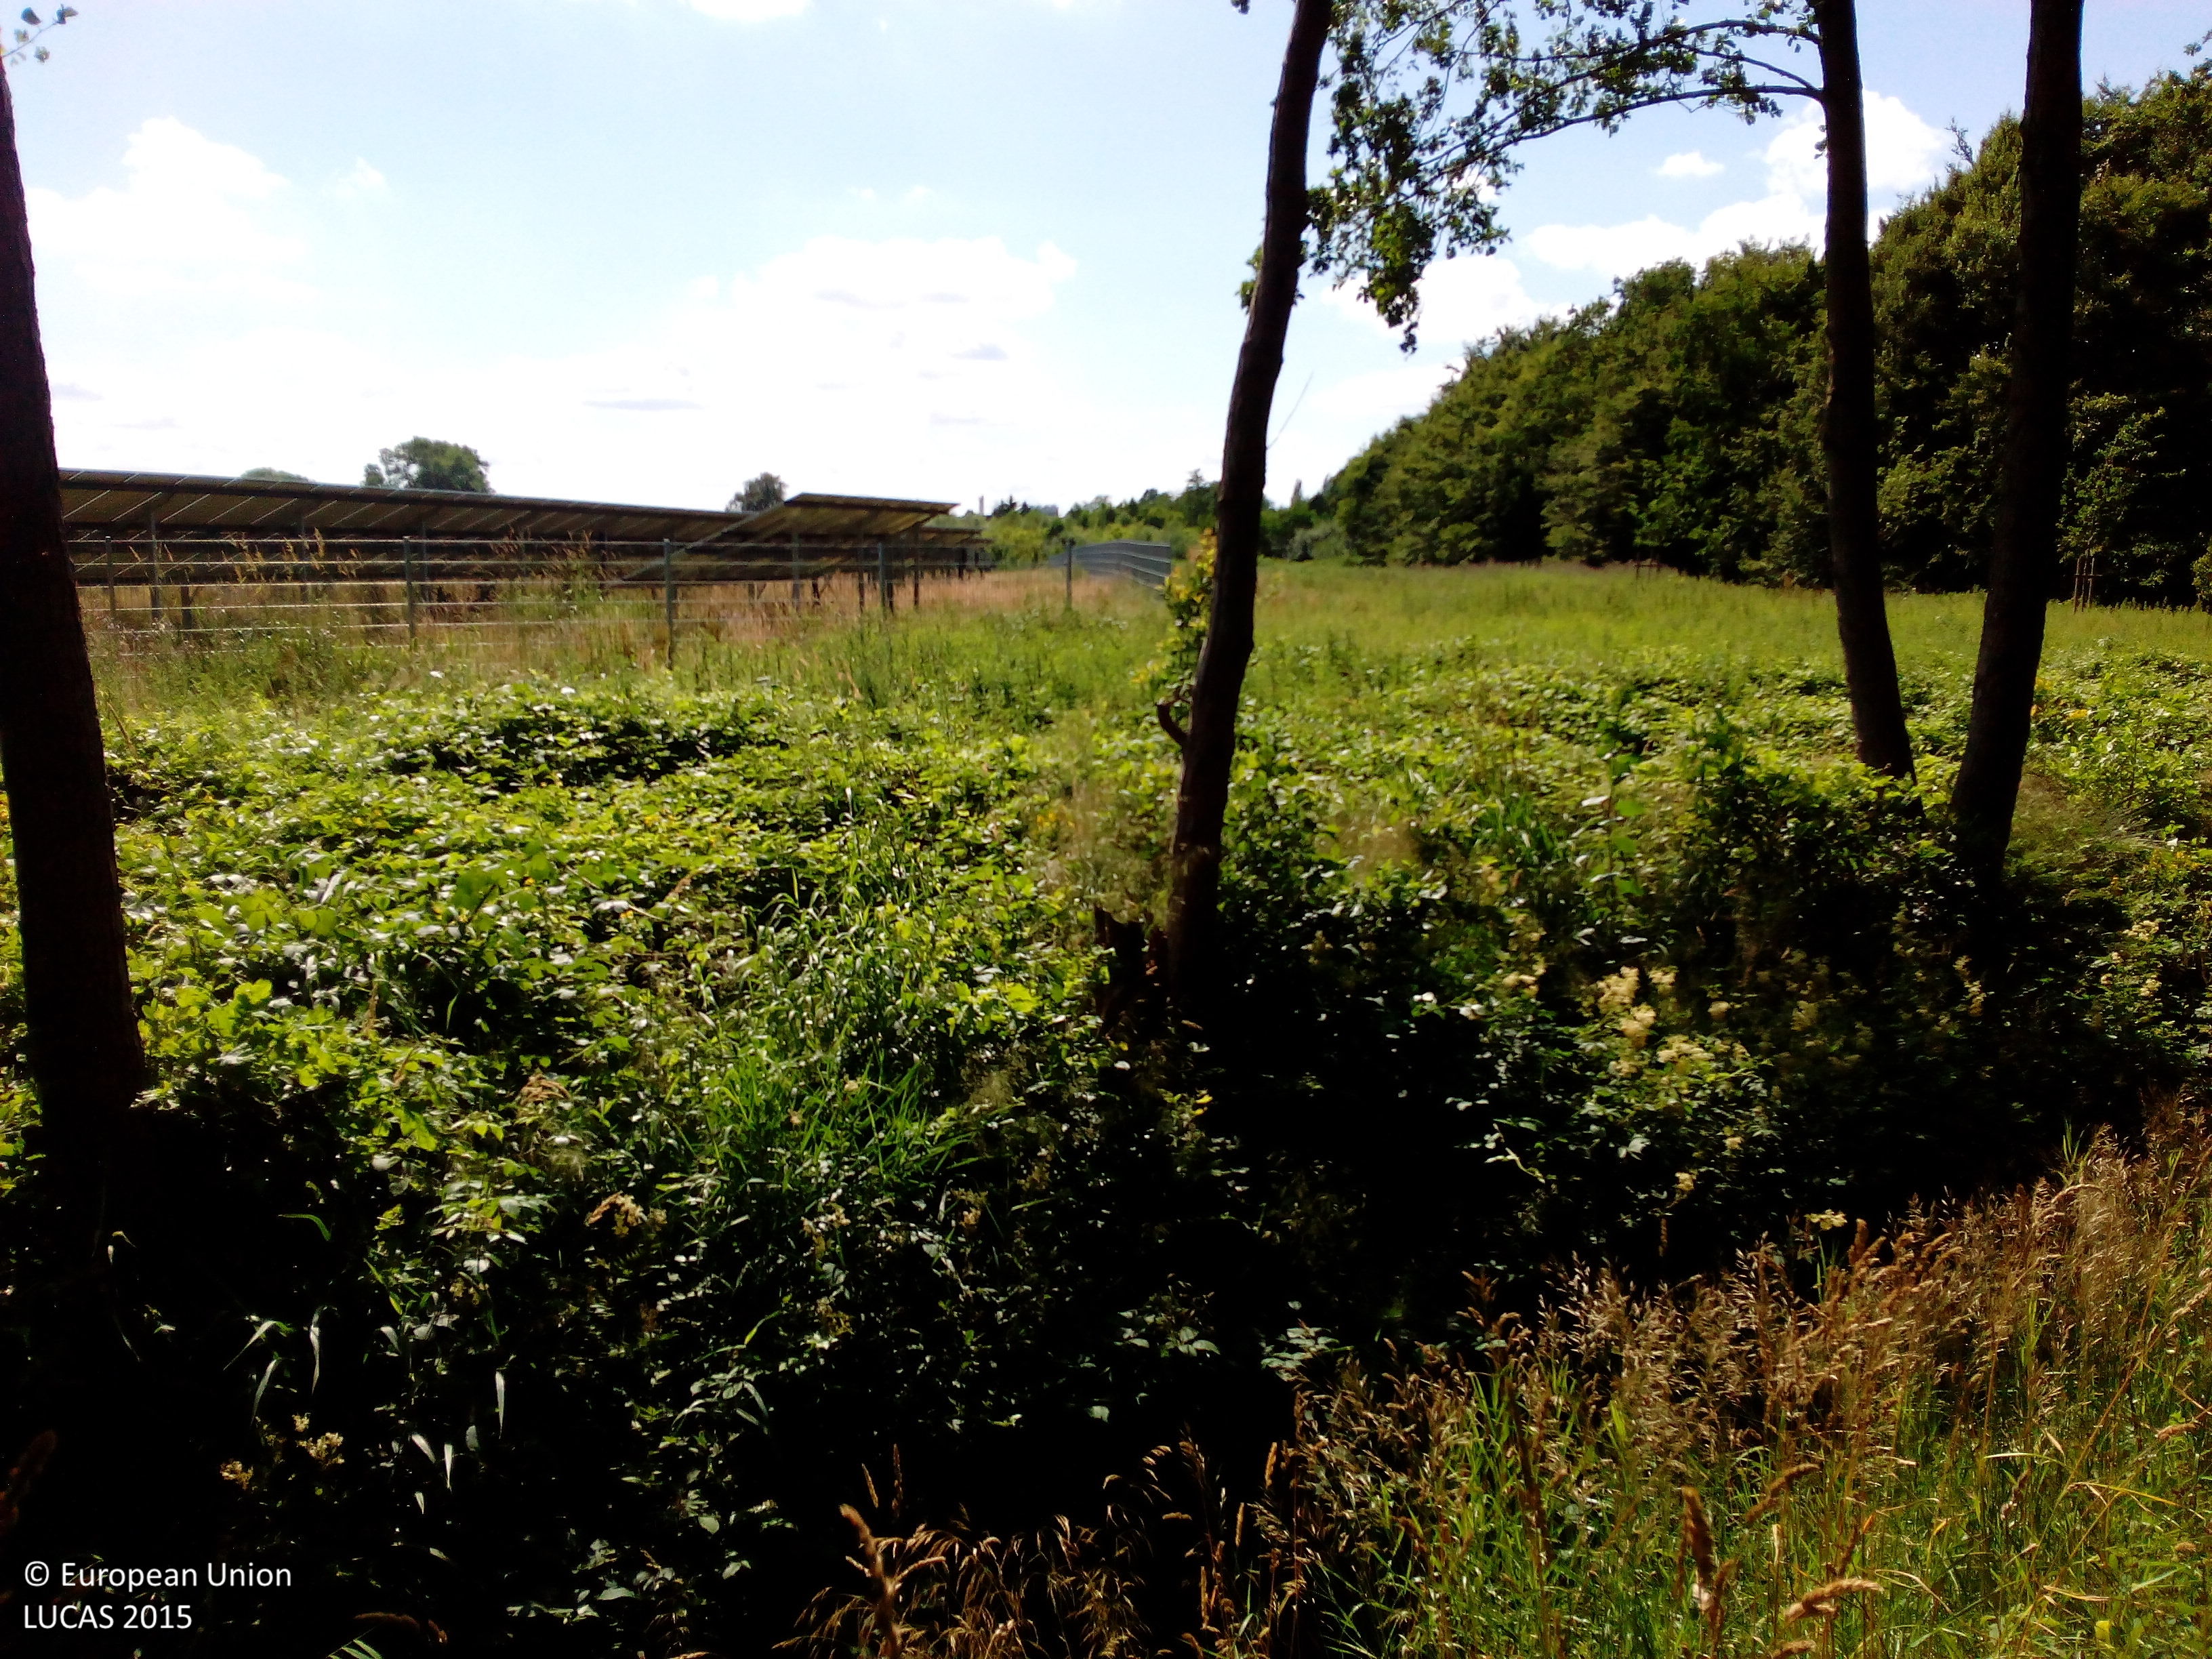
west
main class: Artificial land
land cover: Other artificial areas
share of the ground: > 75 %
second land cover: Grassland without tree/shrub cover
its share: > 75 %
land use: Energy production
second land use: Agriculture (excluding fallow land and kitchen gardens)
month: July
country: DE
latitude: 53.1155
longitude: 7.9836
